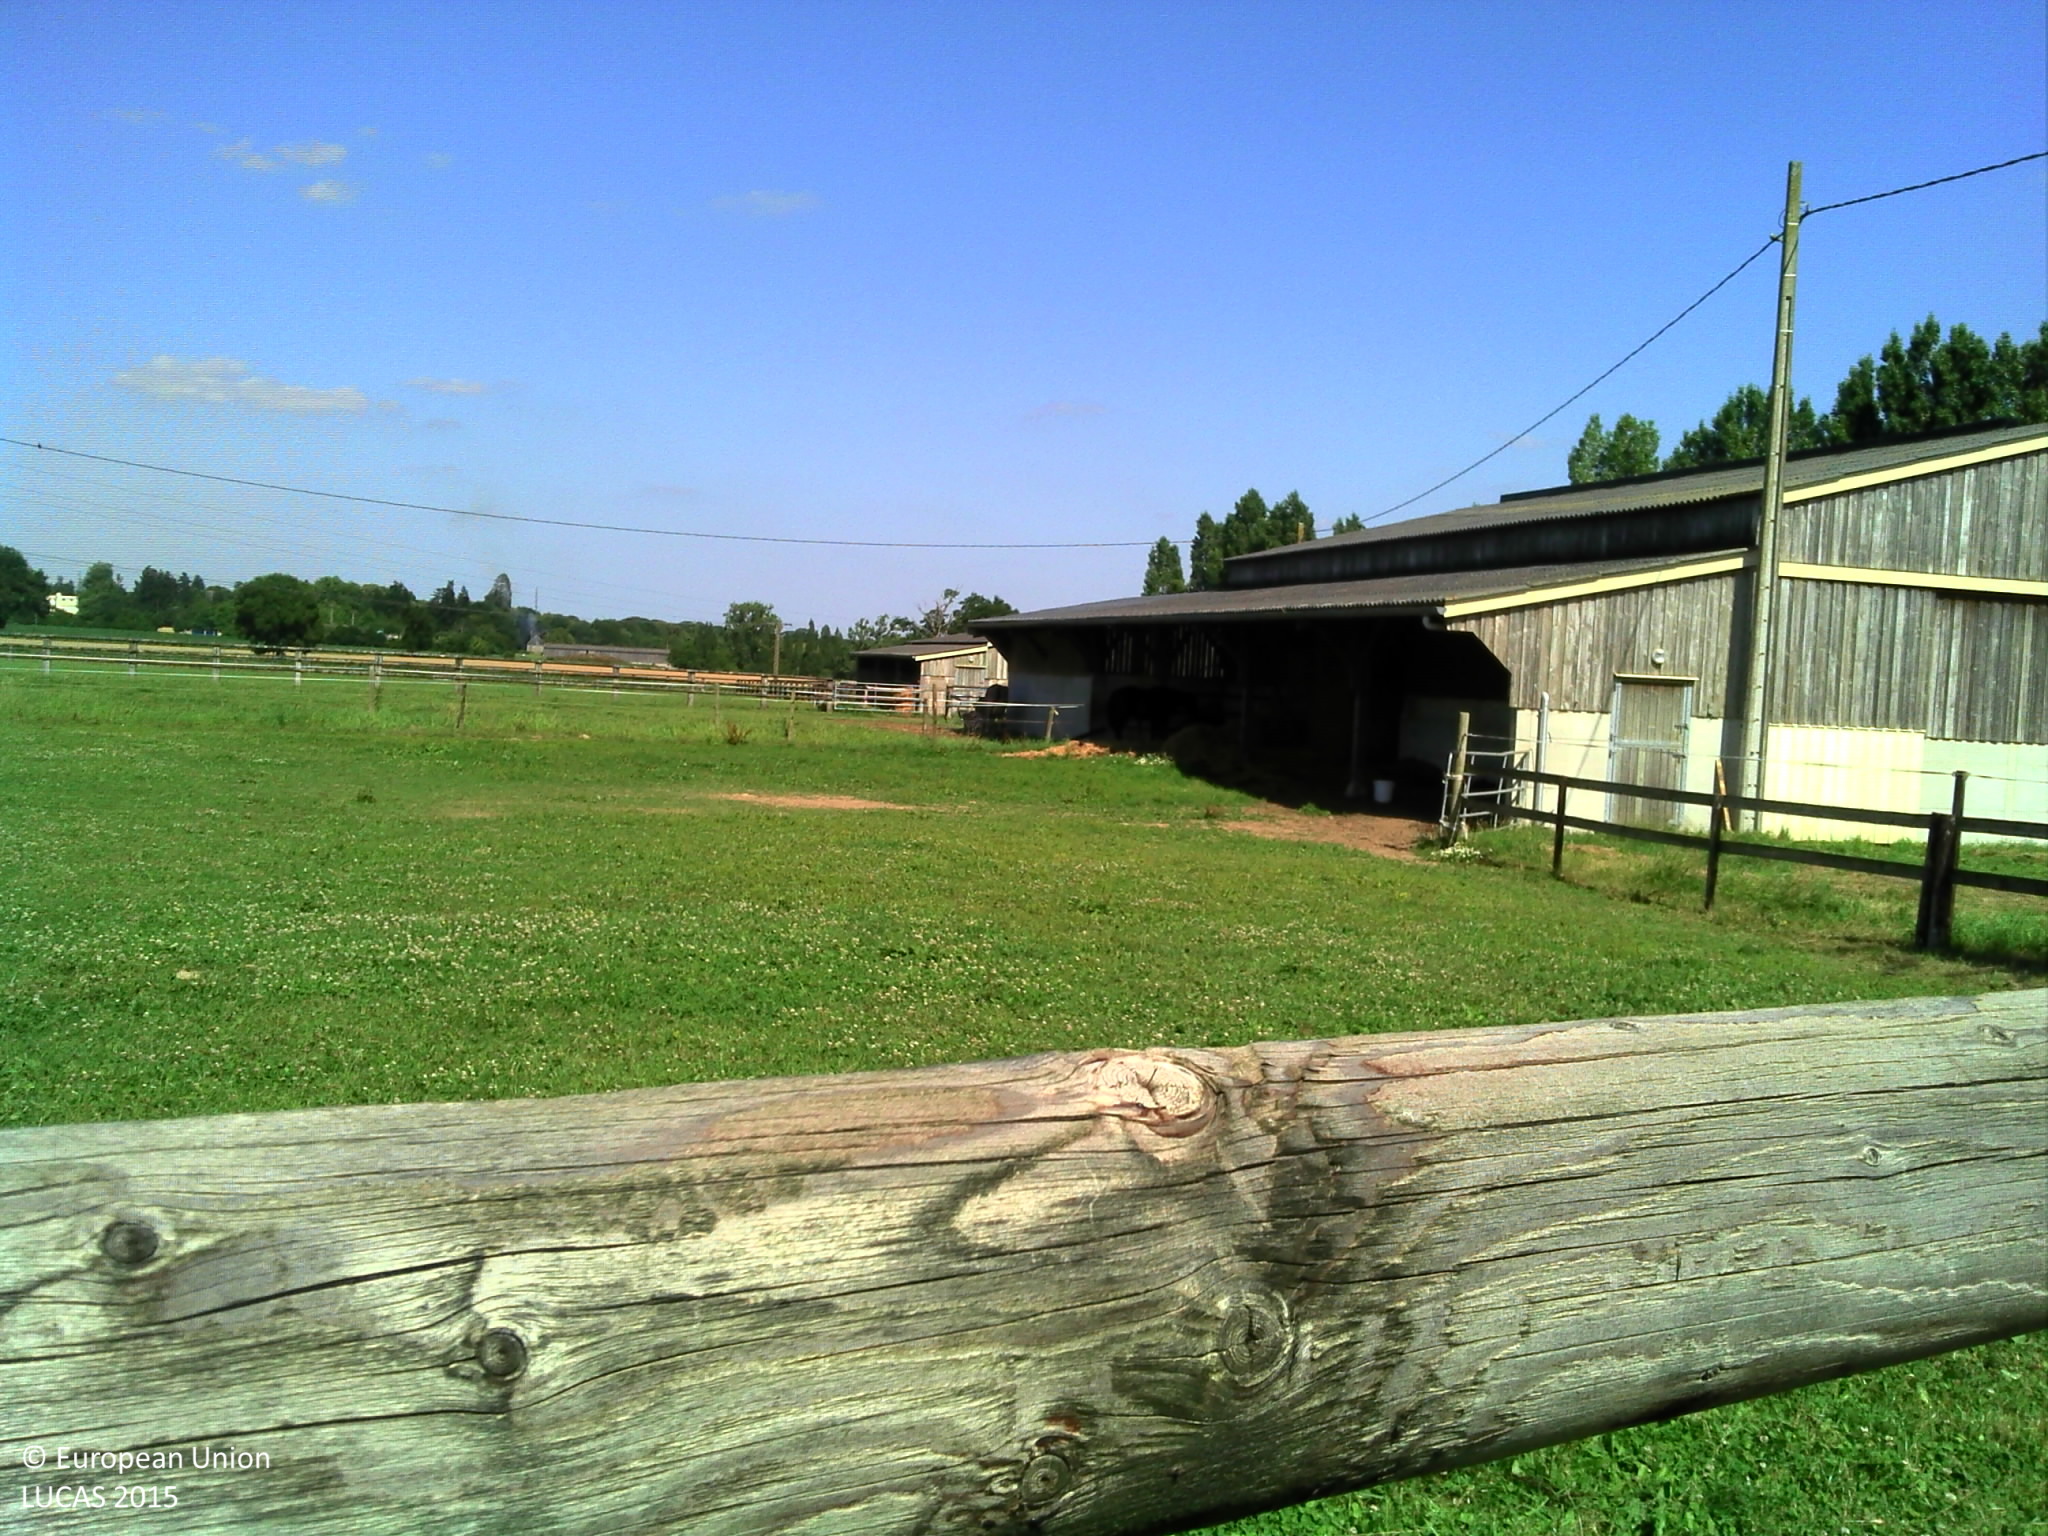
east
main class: Grassland
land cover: Grassland without tree/shrub cover
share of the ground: > 75 %
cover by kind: herbaceous plants 100 %
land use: Sport
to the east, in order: Grassland without tree/shrub cover; Fences; Grassland without tree/shrub cover; Fences; Electric lines; Artificial constructions in urban areas; Grassland without tree/shrub cover; Fences; Grassland without tree/shrub cover; Fences; Grassland without tree/shrub cover; Single bushes/trees; Maize
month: July
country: FR
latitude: 48.0515
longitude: -1.1900
